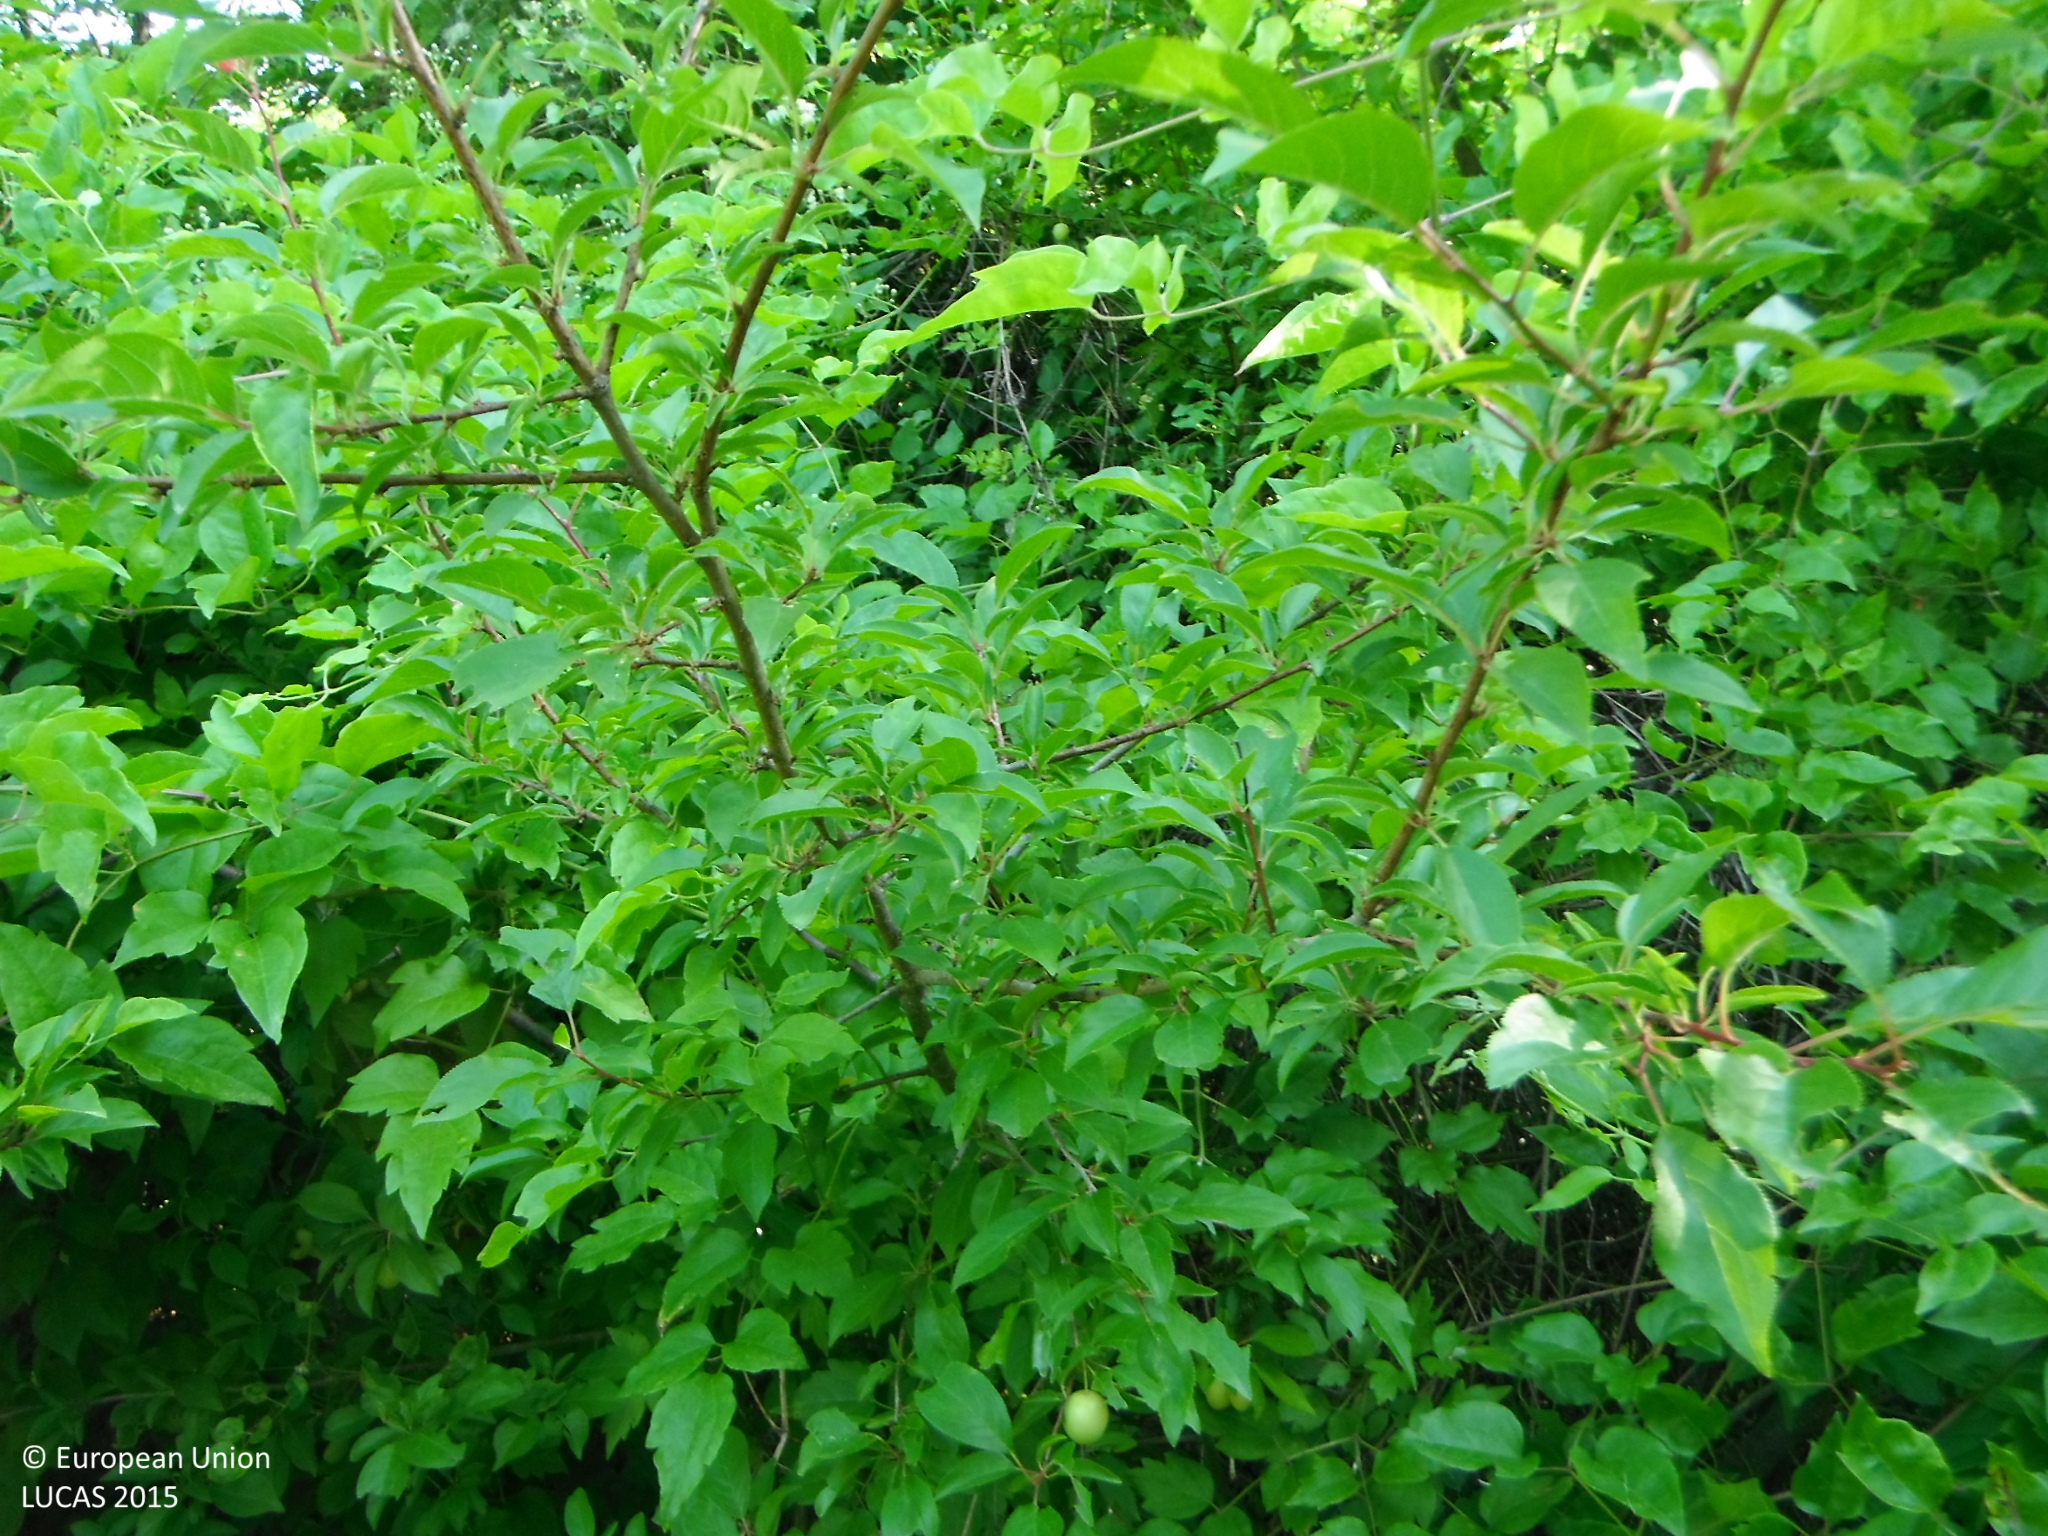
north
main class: Shrubland
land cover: Shrubland with sparse tree cover
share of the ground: > 75 %
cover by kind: shrubs 60 %, herbaceous plants 35 %, broadleaved forest trees 5 %
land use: Semi-natural and natural areas not in use
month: June
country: SK
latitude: 48.2159
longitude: 17.8314
